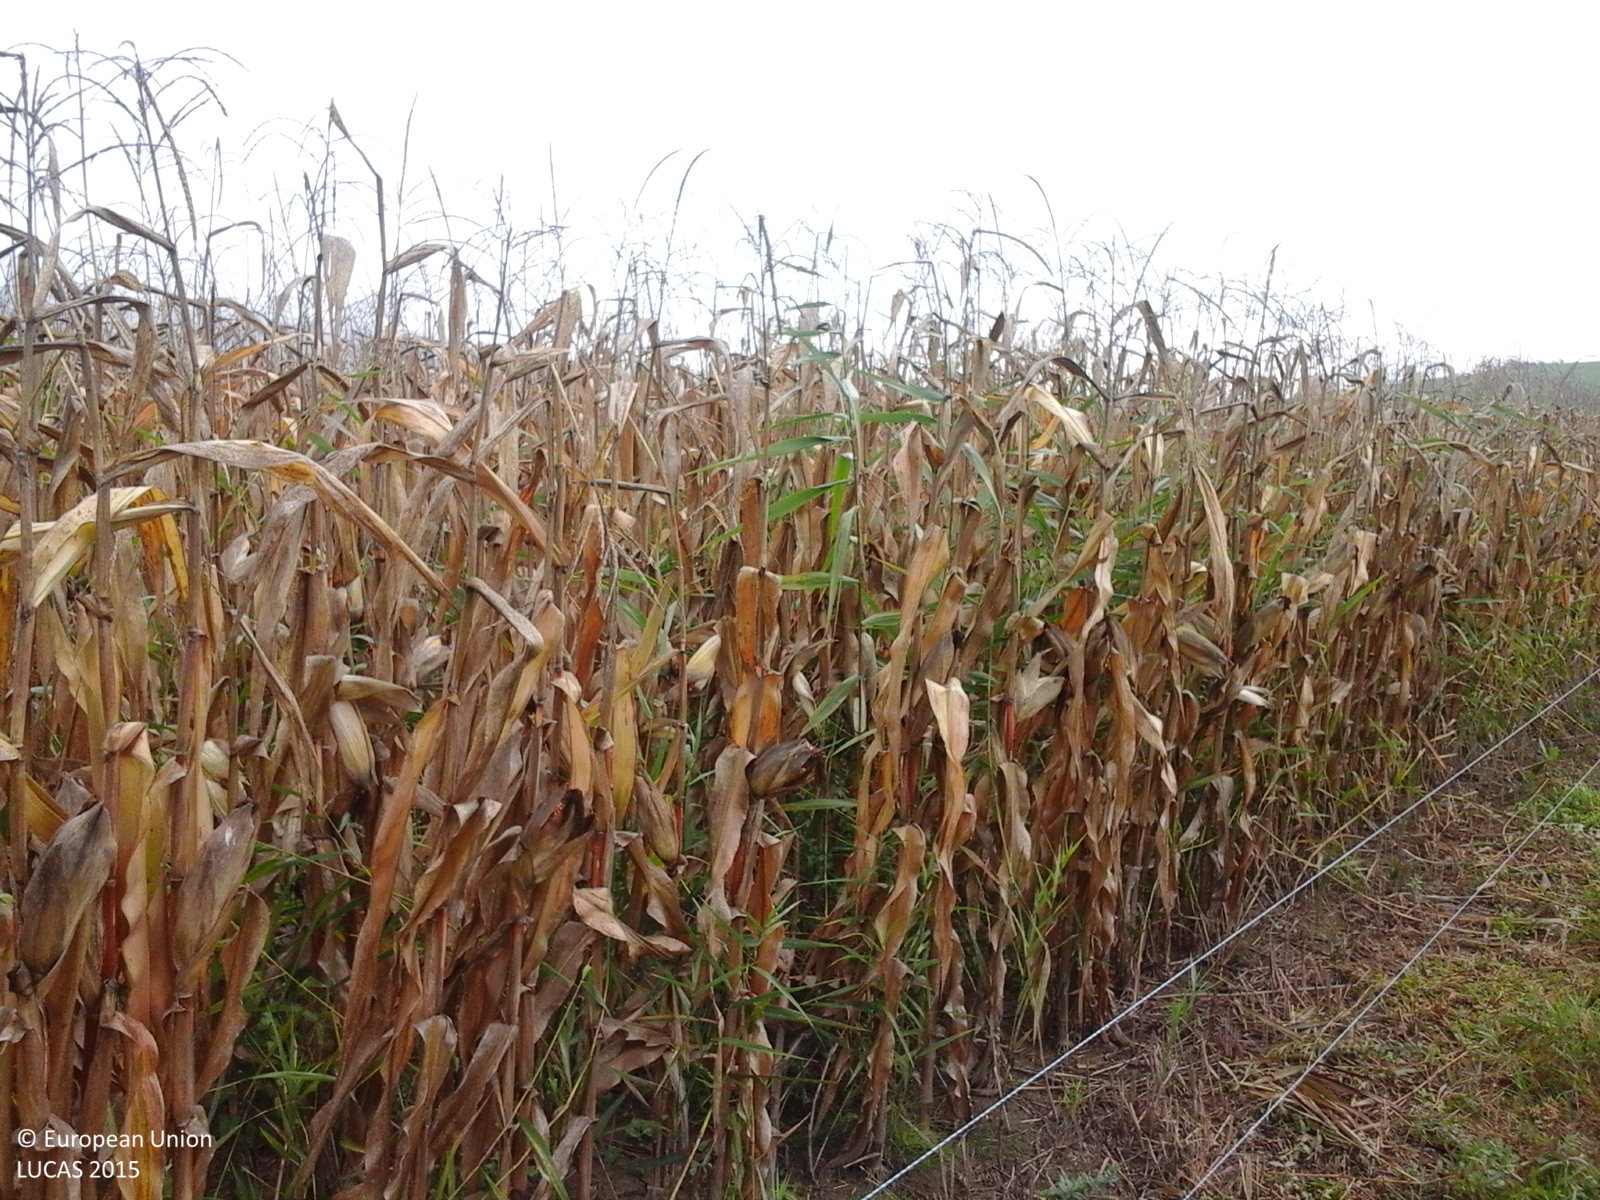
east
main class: Cropland
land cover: Maize
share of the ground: > 75 %
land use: Agriculture (excluding fallow land and kitchen gardens)
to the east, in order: Tracks; Fences; Maize
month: October
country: RO
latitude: 46.2419
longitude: 24.1759
